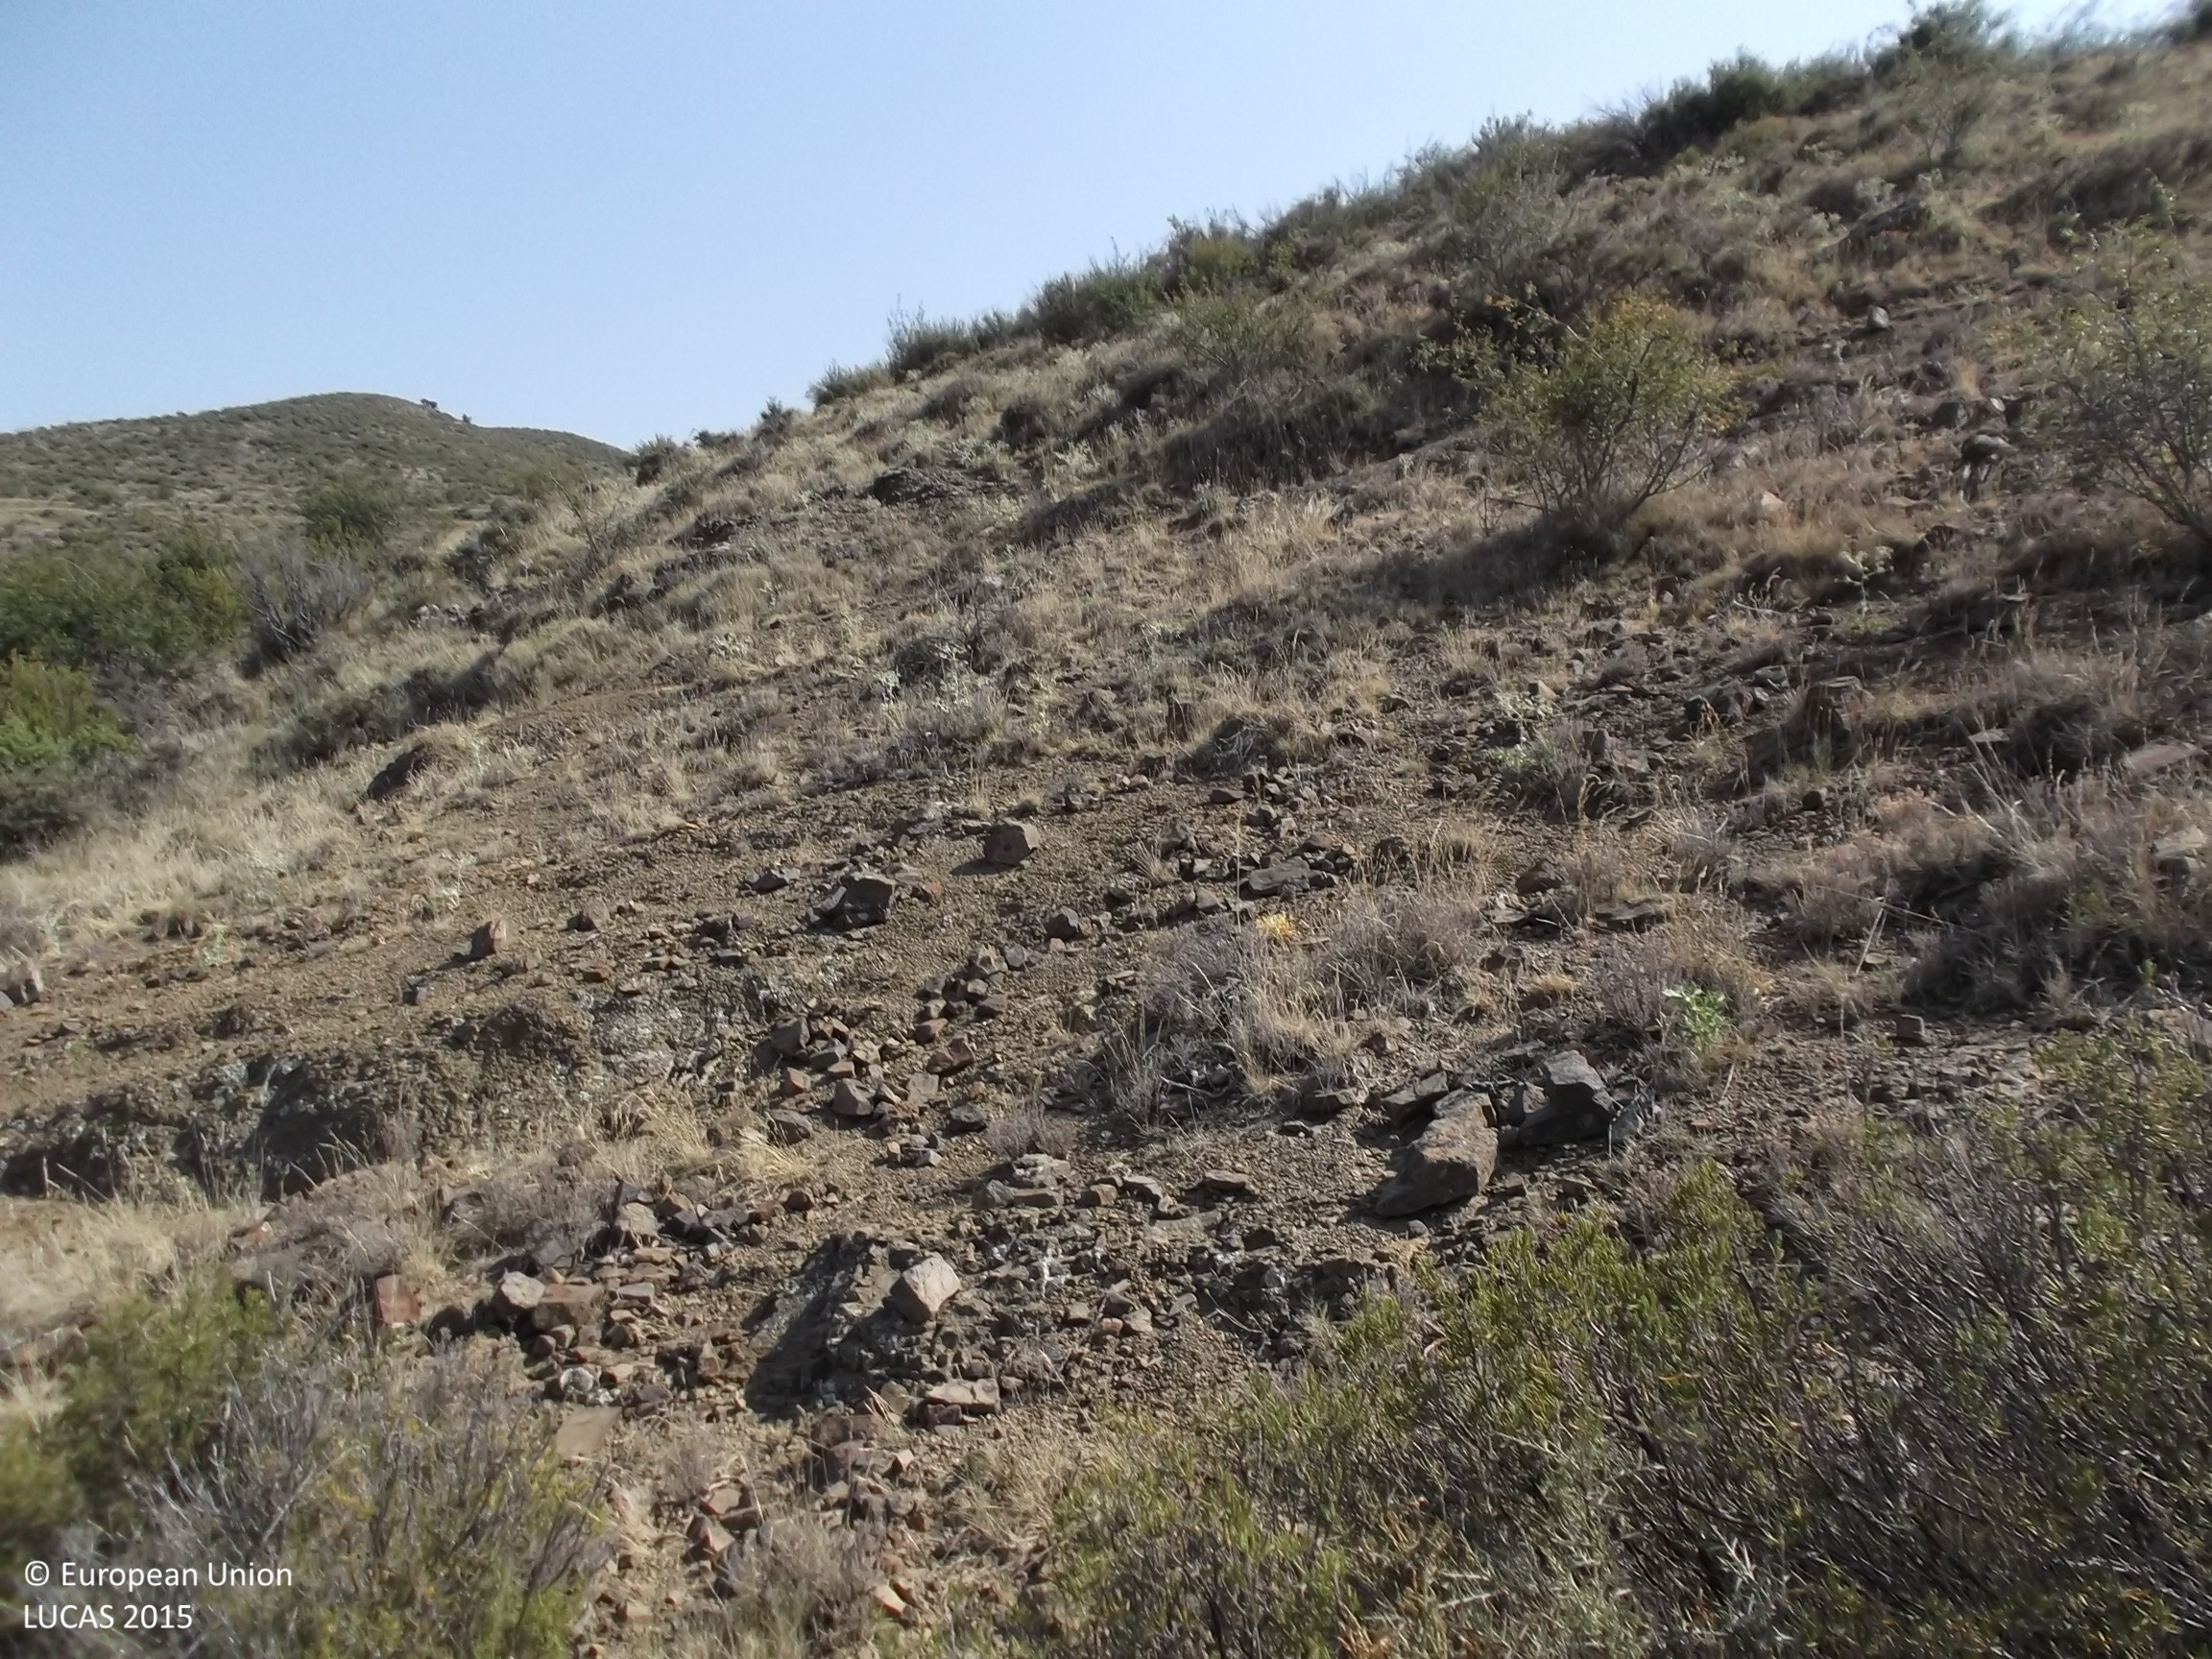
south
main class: Shrubland
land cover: Shrubland without tree cover
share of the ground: 25 - 50 %
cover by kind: shrubs 40 %, herbaceous plants 30 %, unconsolidated bare surface 30 %
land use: Agriculture (excluding fallow land and kitchen gardens)
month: July
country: ES
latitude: 42.0761
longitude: -2.0634
